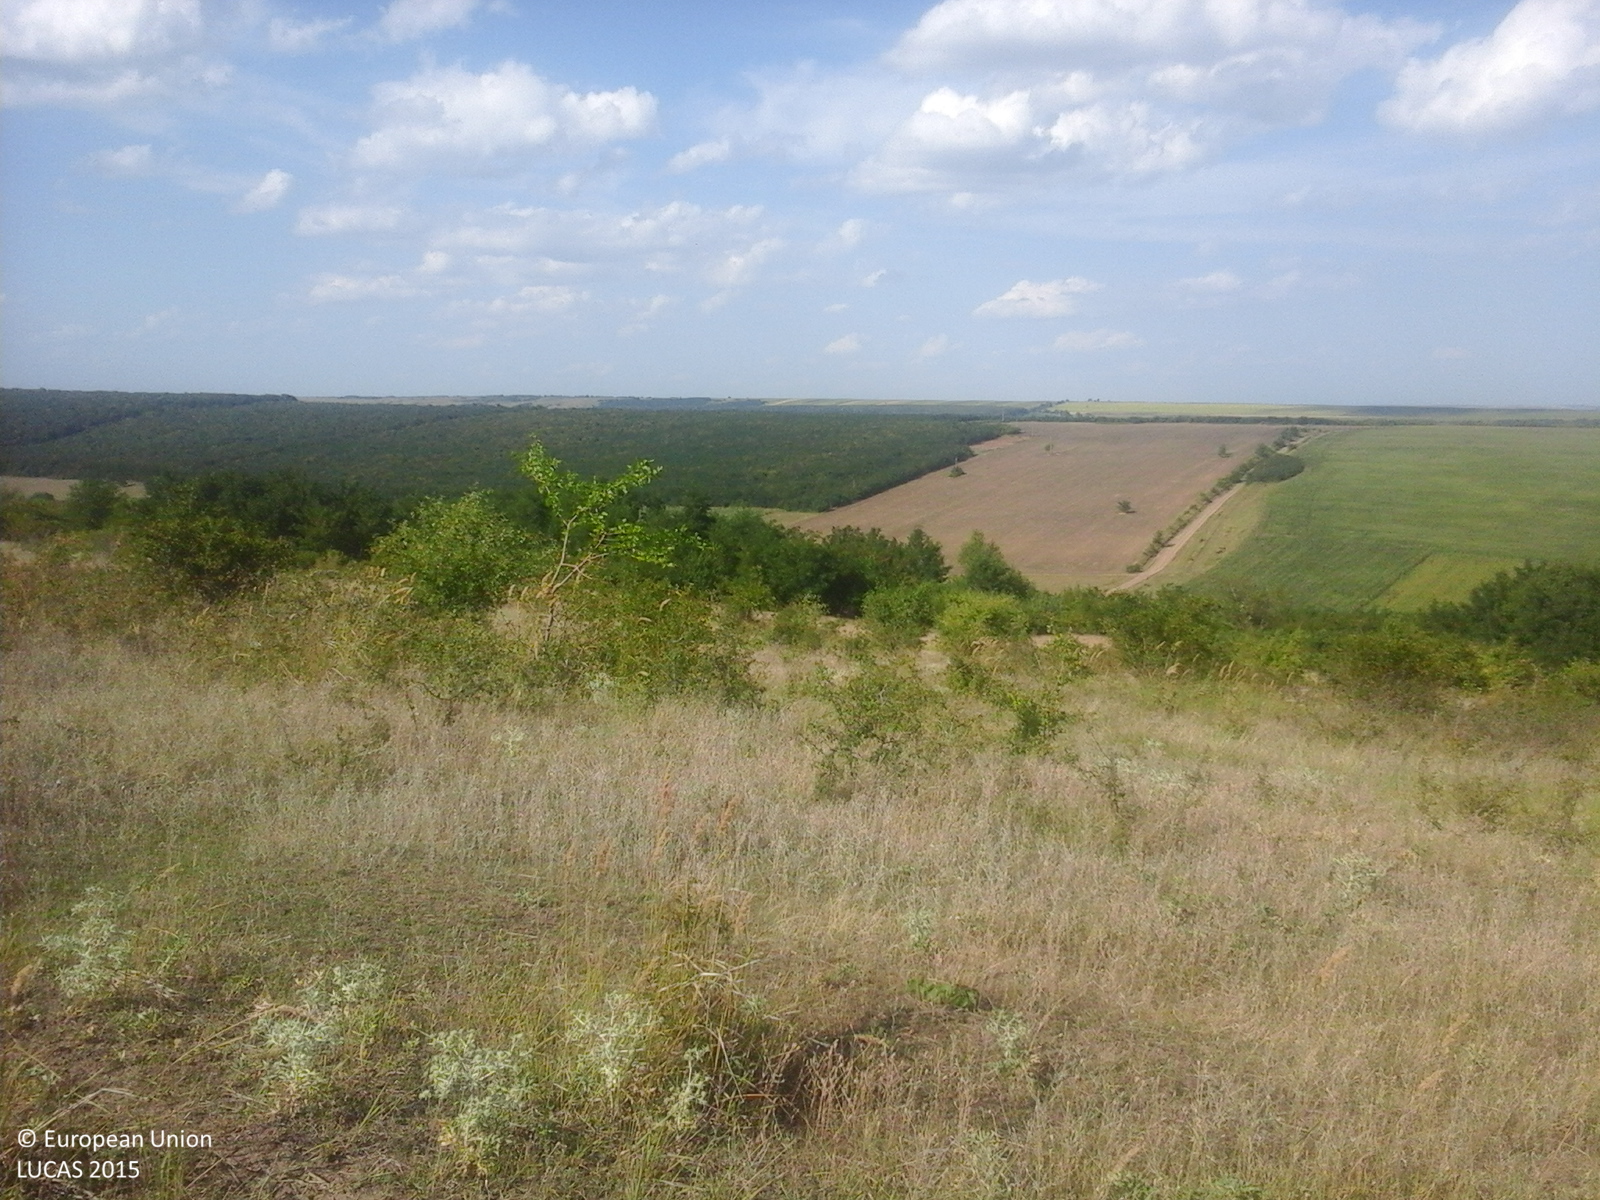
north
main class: Grassland
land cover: Grassland with sparse tree/shrub cover
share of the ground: > 75 %
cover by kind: herbaceous plants 85 %, shrubs 10 %, broadleaved forest trees 5 %
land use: Agriculture (excluding fallow land and kitchen gardens)
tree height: < 5 m
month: July
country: RO
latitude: 46.4748
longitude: 27.9549
